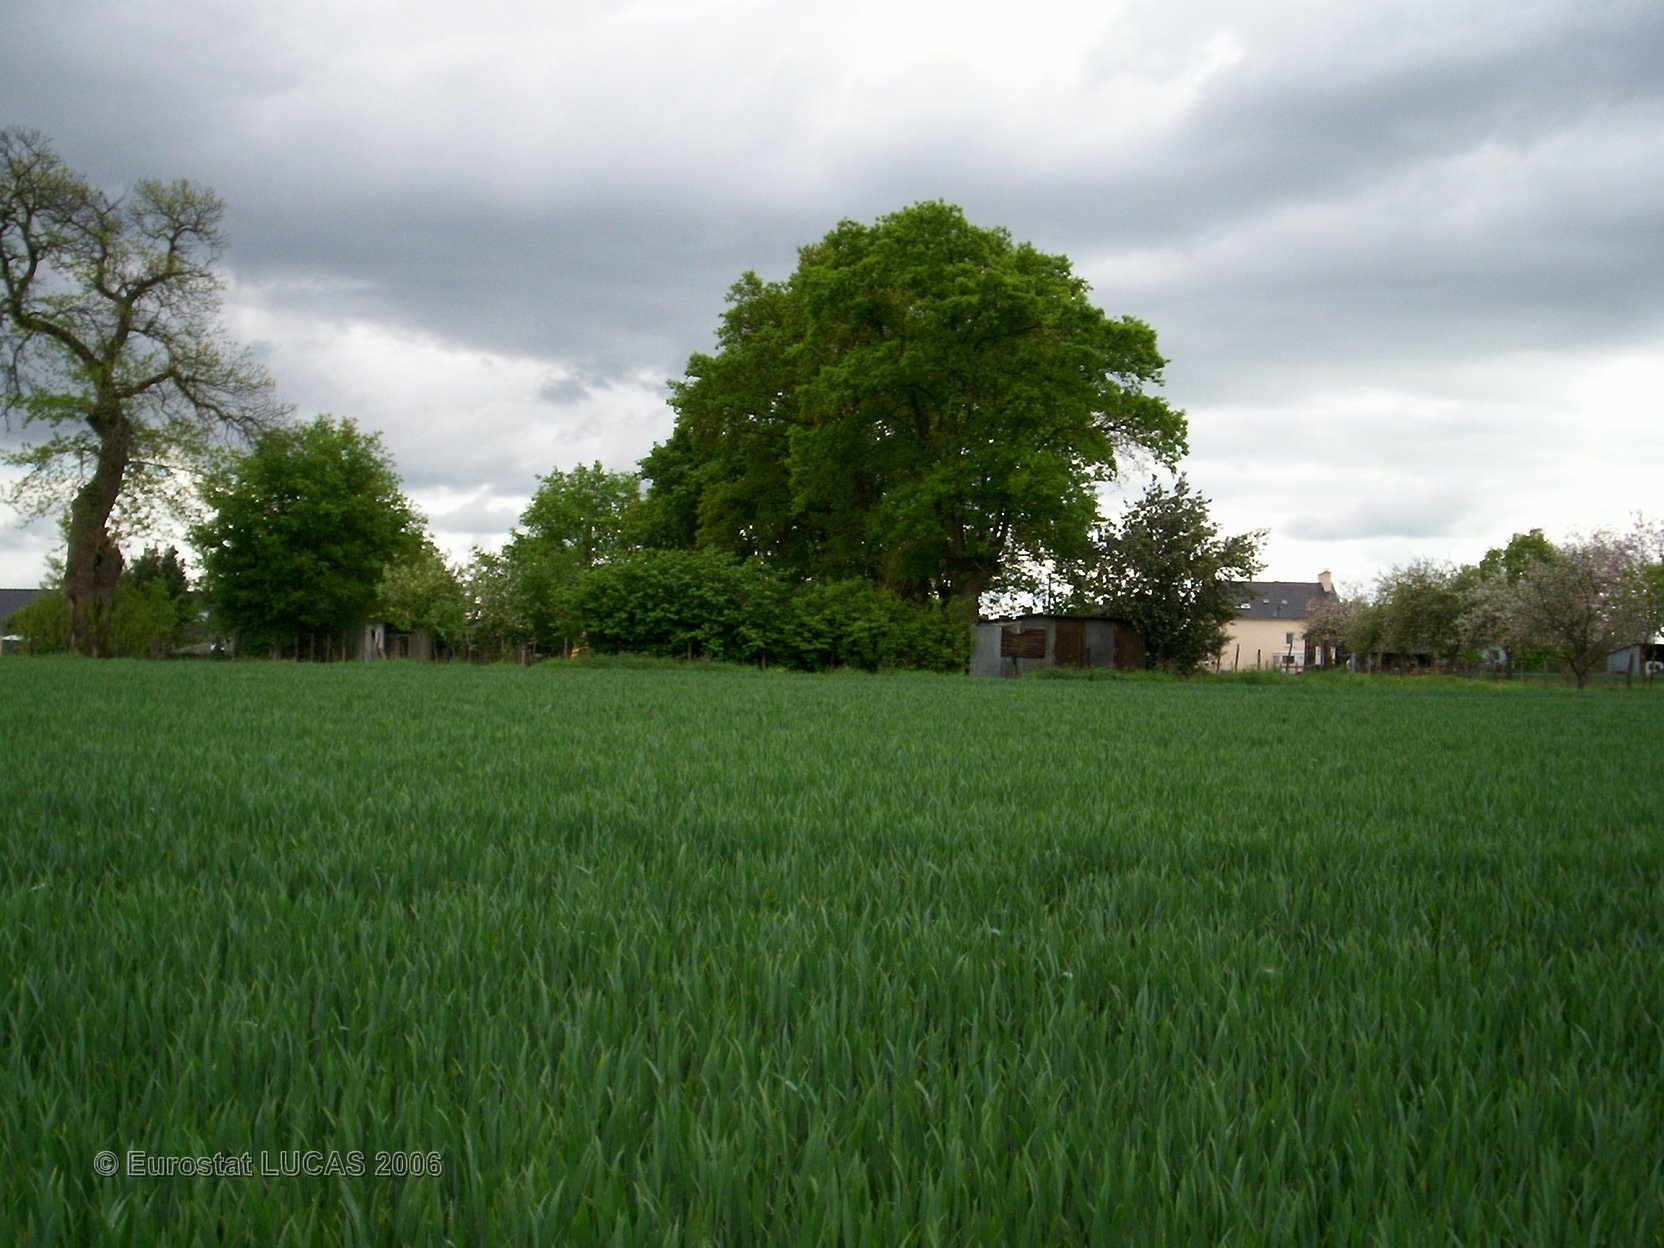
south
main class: Cropland
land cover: Triticale
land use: Agriculture (excluding fallow land and kitchen gardens)
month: May
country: FR
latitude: 47.5626
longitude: -2.1873
